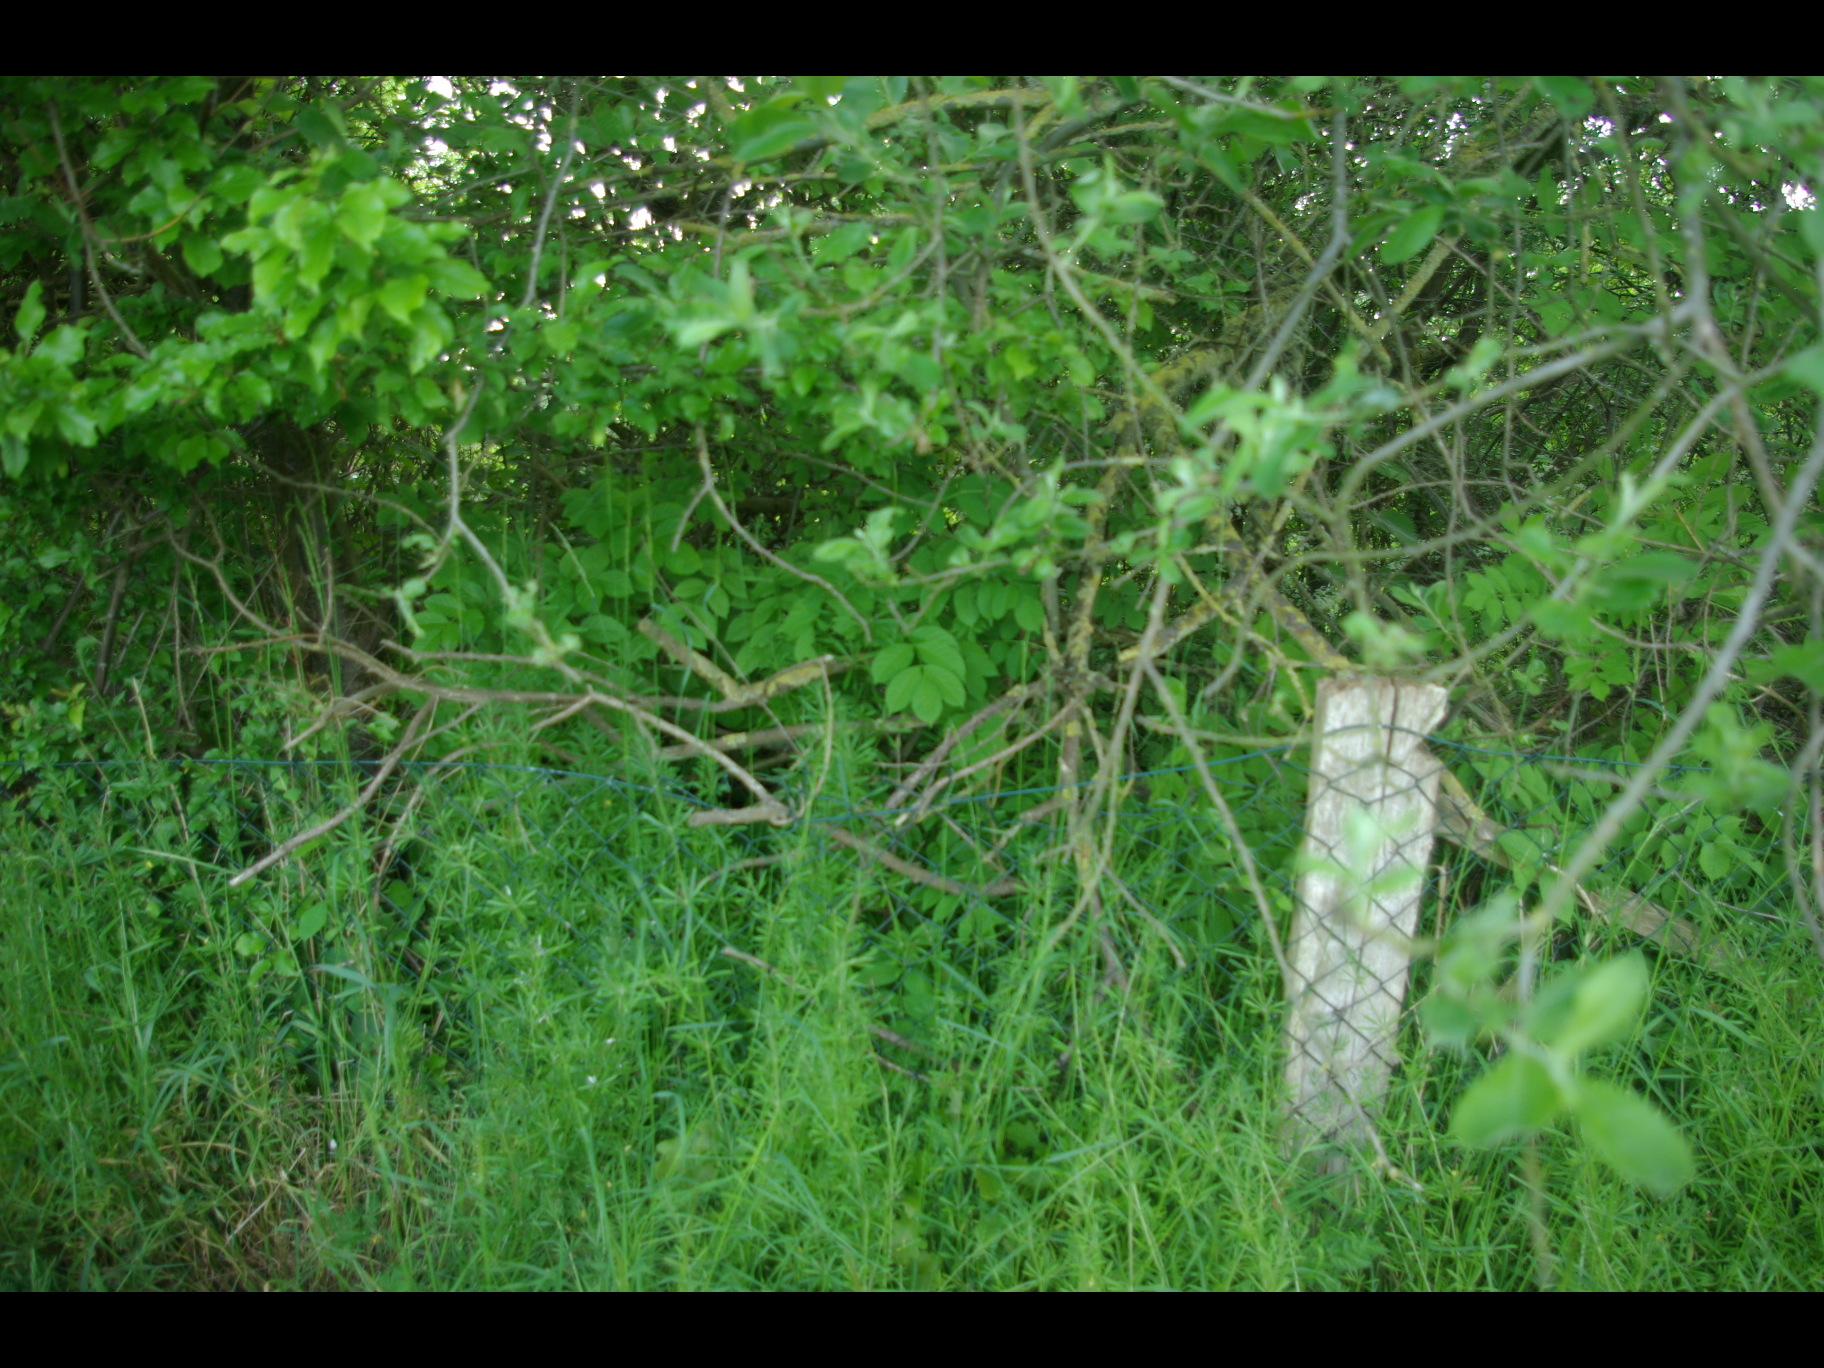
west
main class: Cropland
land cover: Rape and turnip rape
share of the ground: > 75 %
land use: Agriculture (excluding fallow land and kitchen gardens)
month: June
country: DE
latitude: 54.2809
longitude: 10.6293
